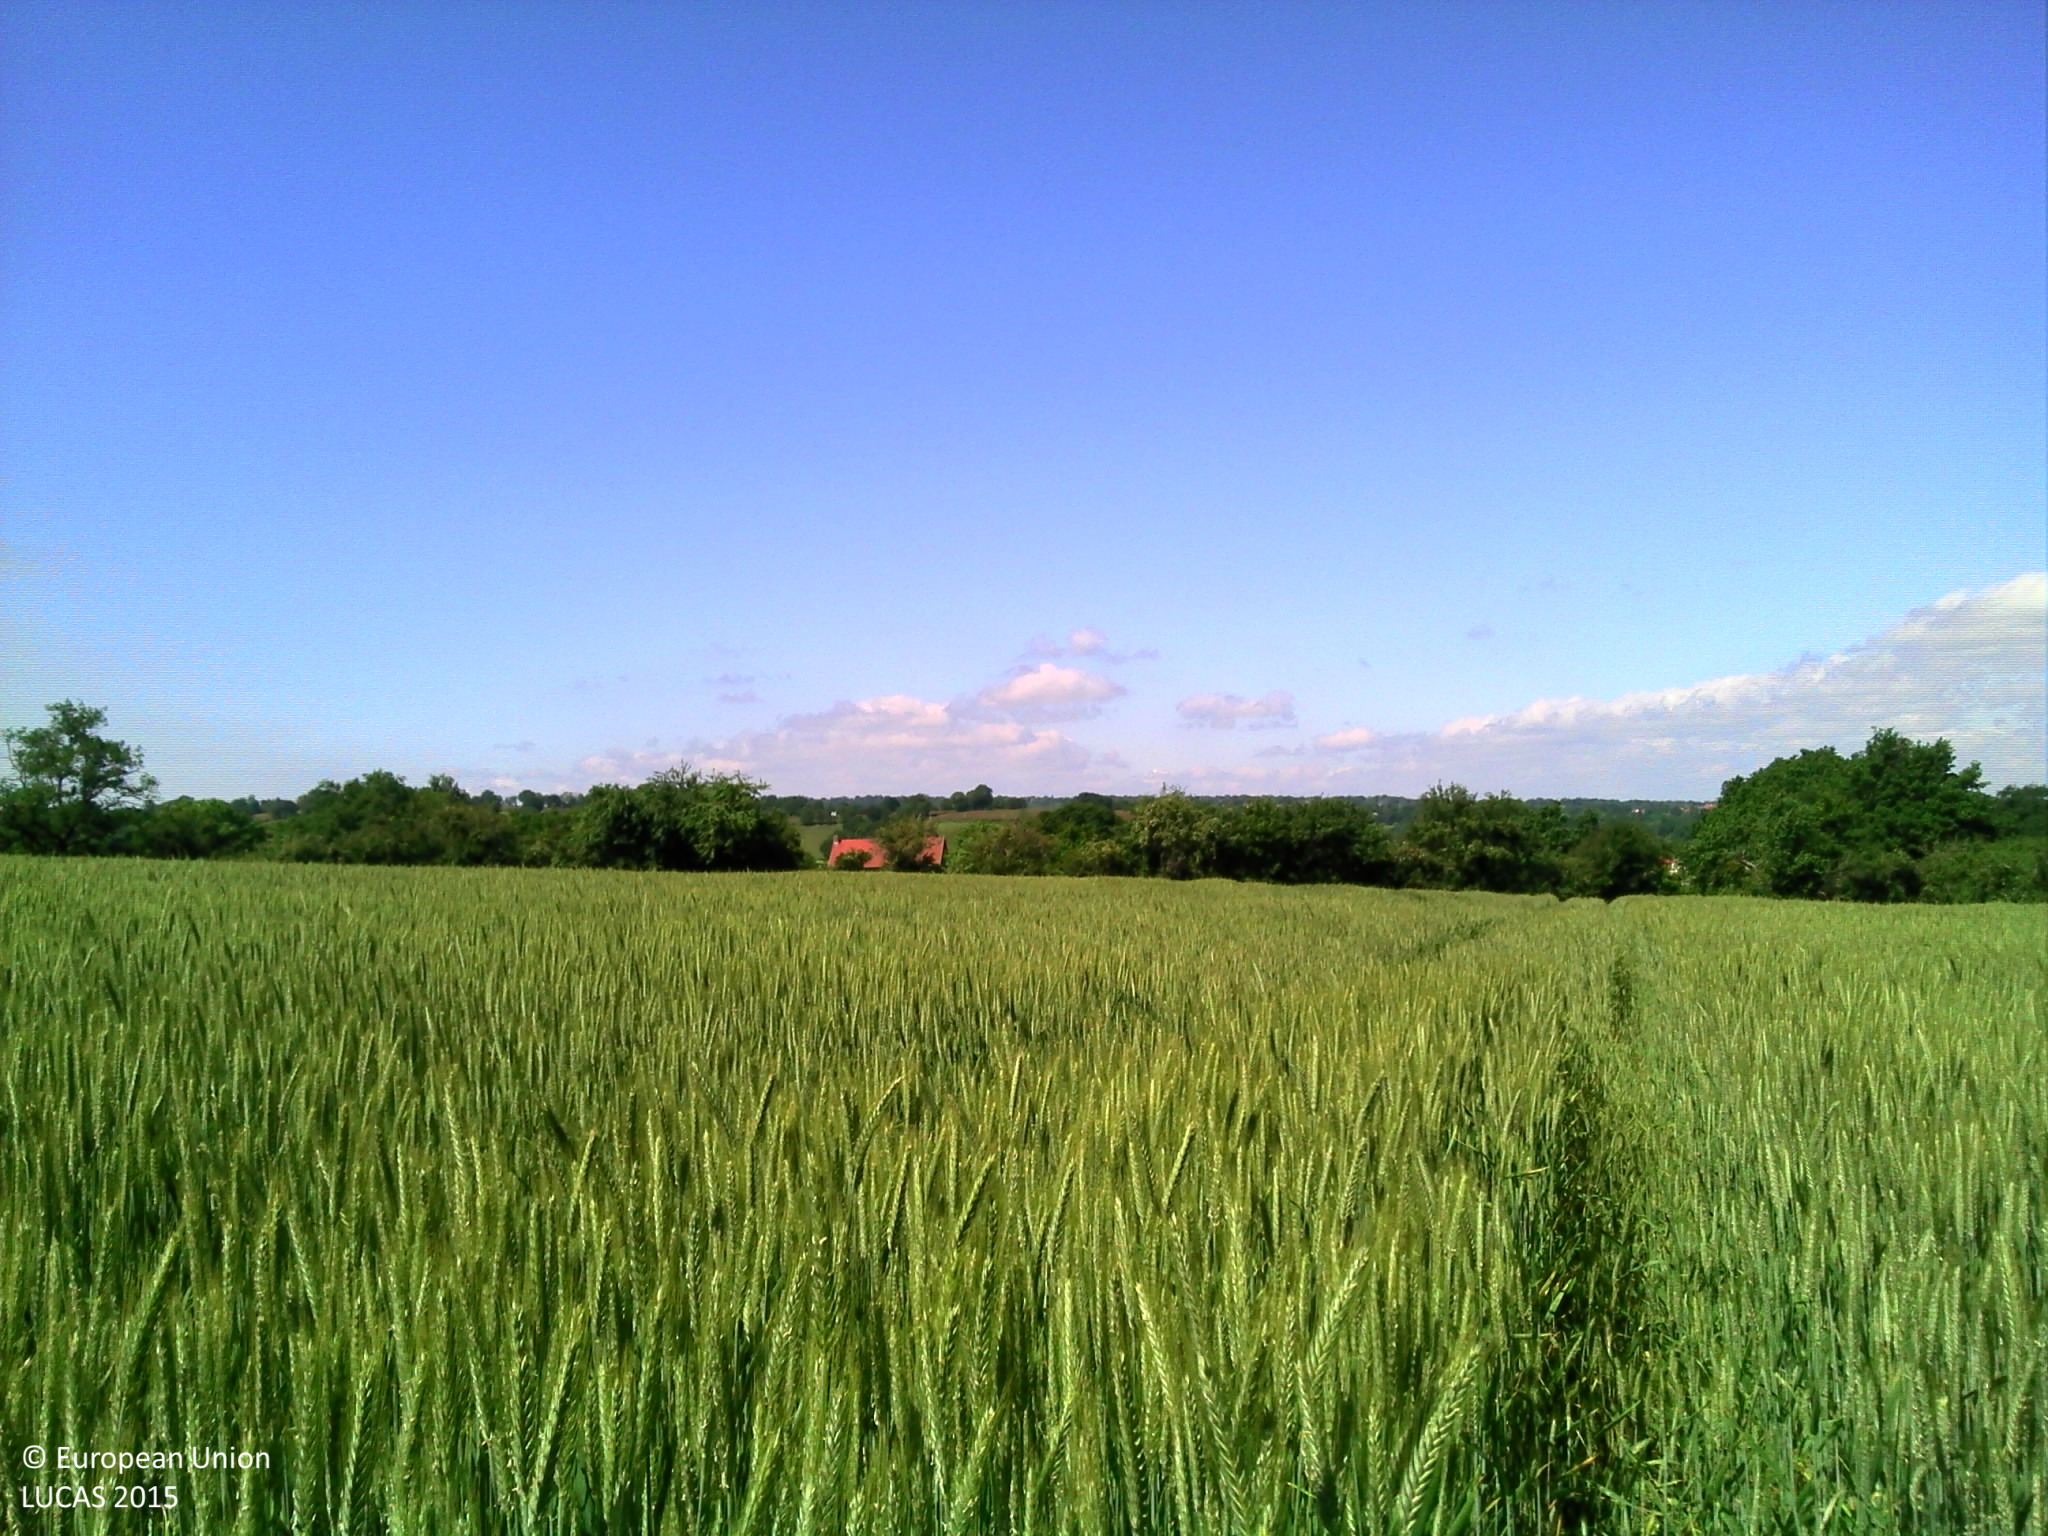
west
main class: Cropland
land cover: Rye
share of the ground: > 75 %
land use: Agriculture (excluding fallow land and kitchen gardens)
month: May
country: FR
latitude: 46.2691
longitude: 2.7696
